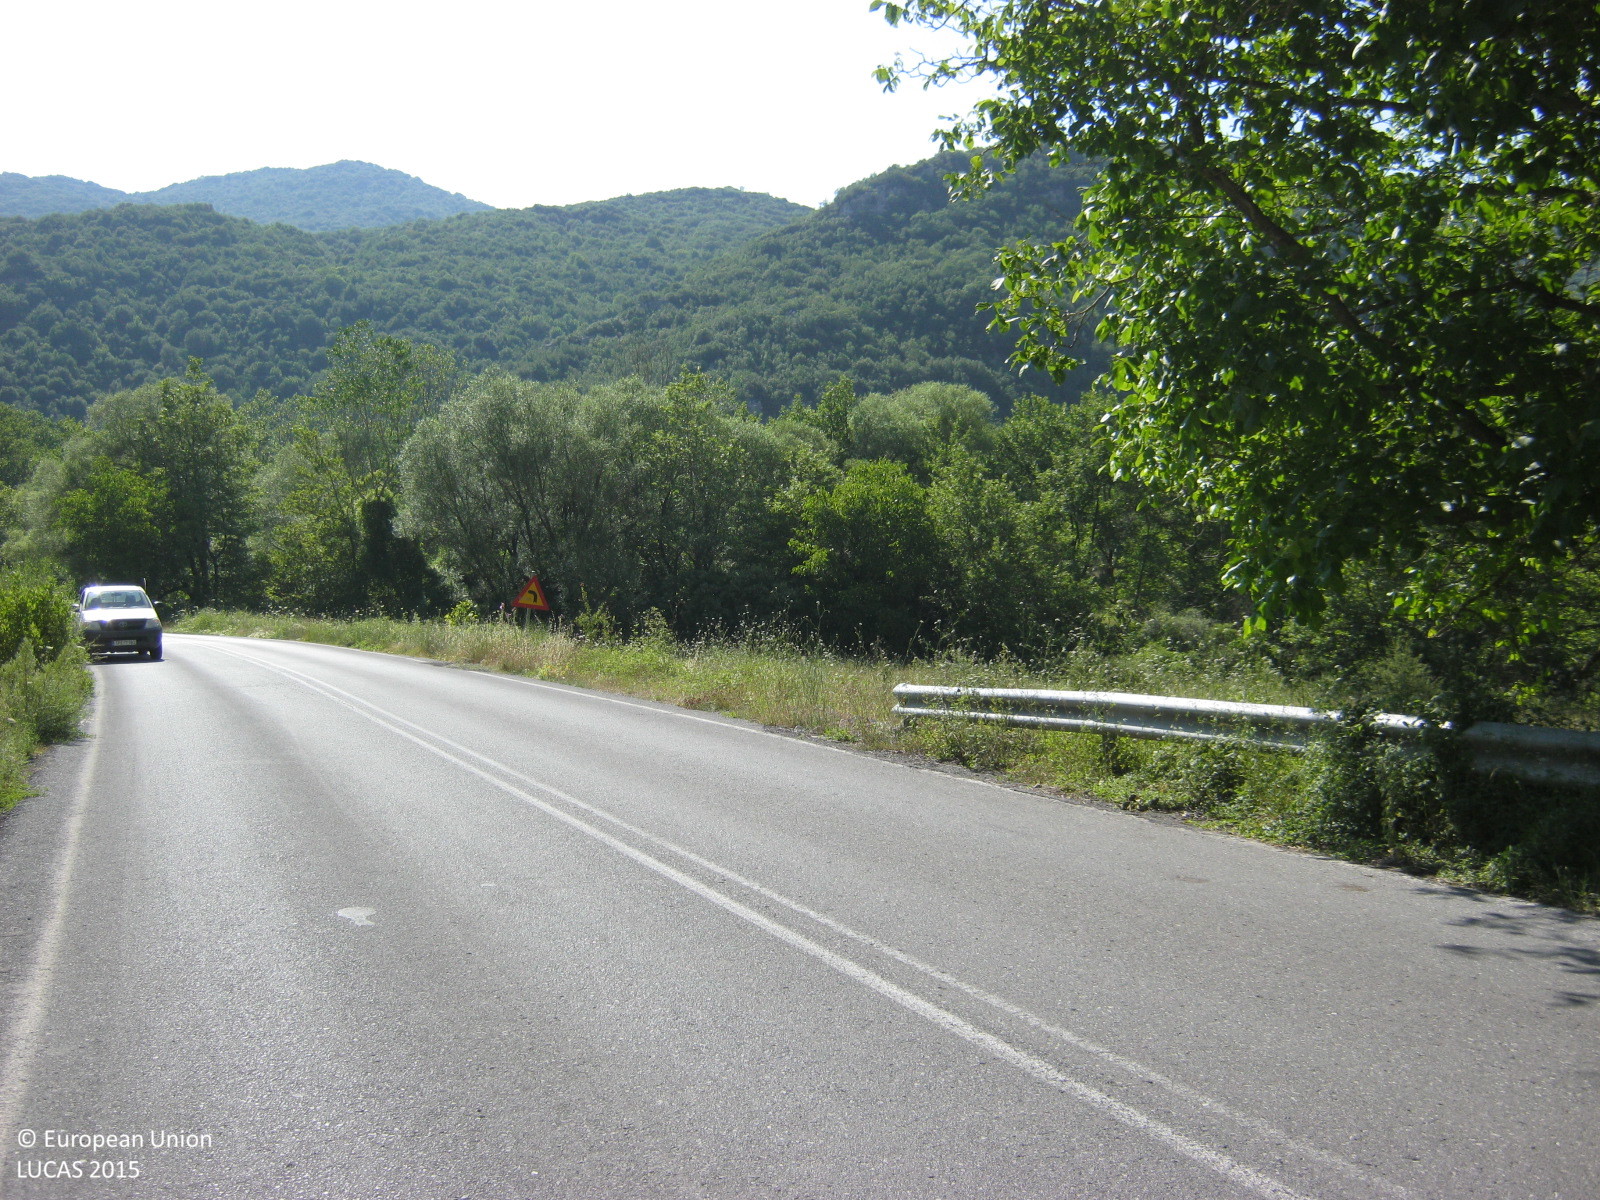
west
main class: Woodland
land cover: Broadleaved woodland
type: thermophilous deciduous forest
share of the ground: 50 - 75 %
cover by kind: broadleaved forest trees 70 %, shrubs 15 %, unconsolidated bare surface 15 %
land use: Semi-natural and natural areas not in use
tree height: < 5 m
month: July
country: GR
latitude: 37.6193
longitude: 22.0499
